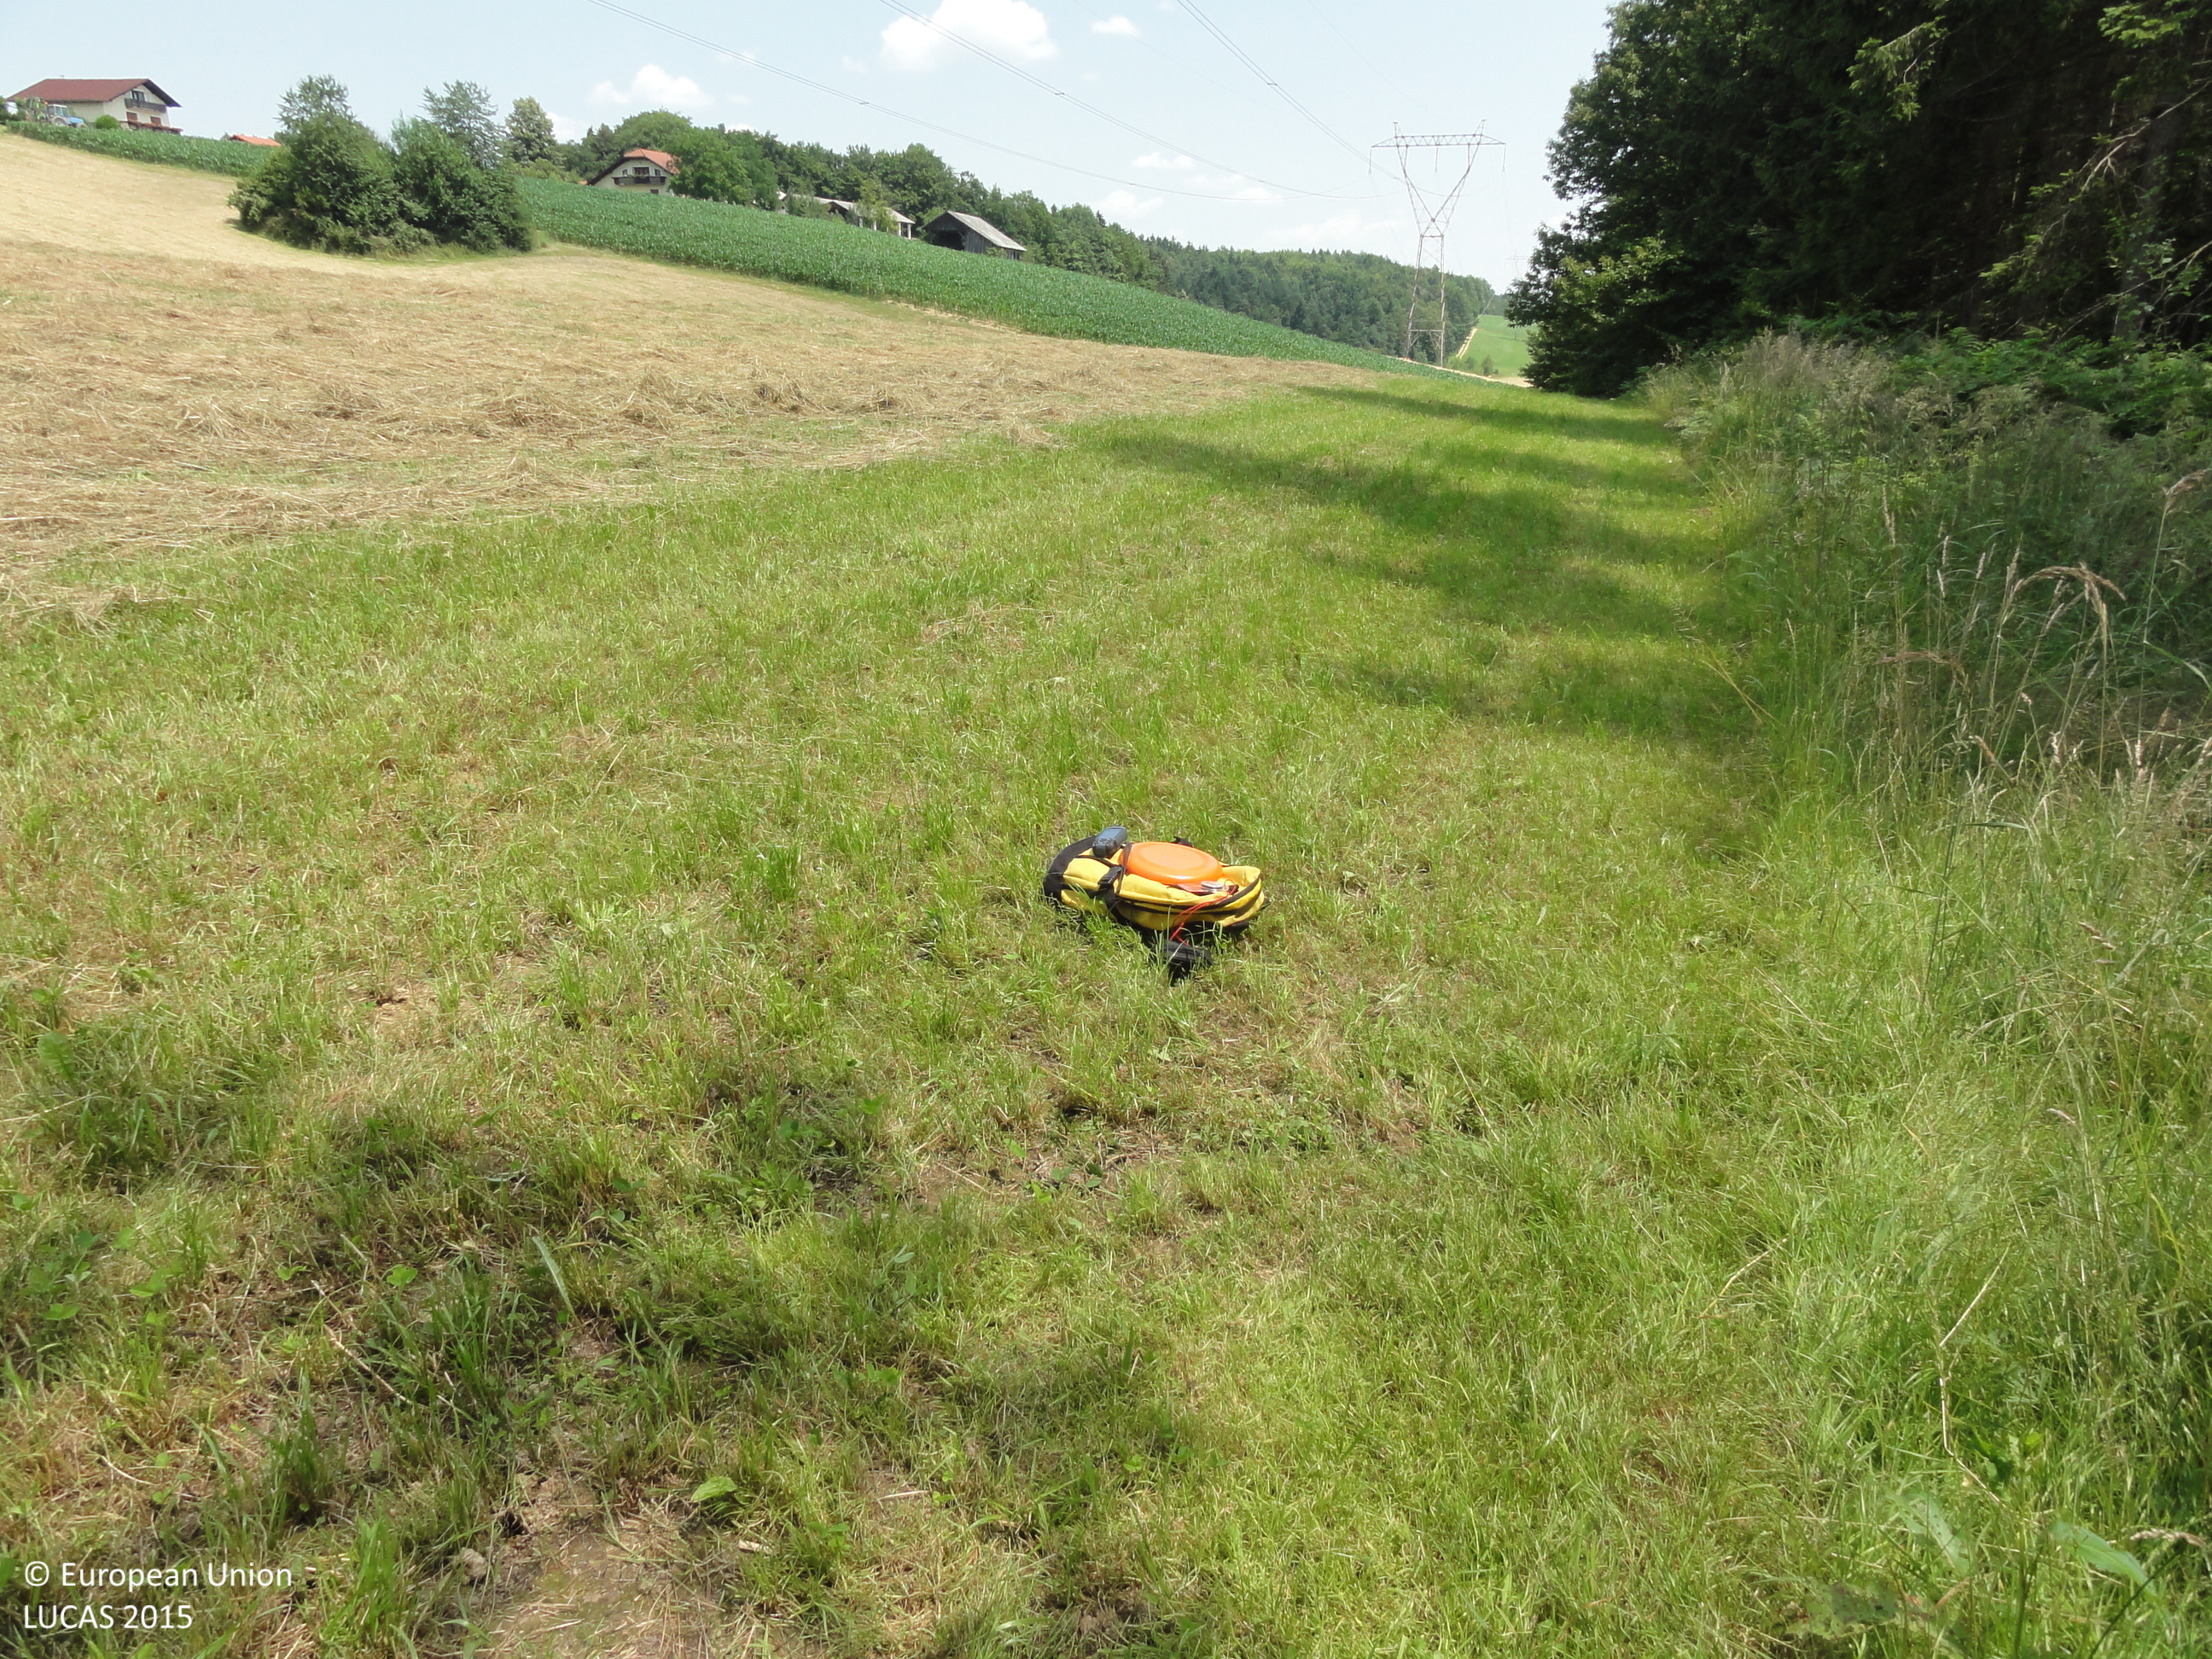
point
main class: Grassland
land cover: Grassland without tree/shrub cover
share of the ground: > 75 %
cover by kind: herbaceous plants 100 %
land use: Agriculture (excluding fallow land and kitchen gardens)
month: July
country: SI
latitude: 46.3351
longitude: 15.5195
